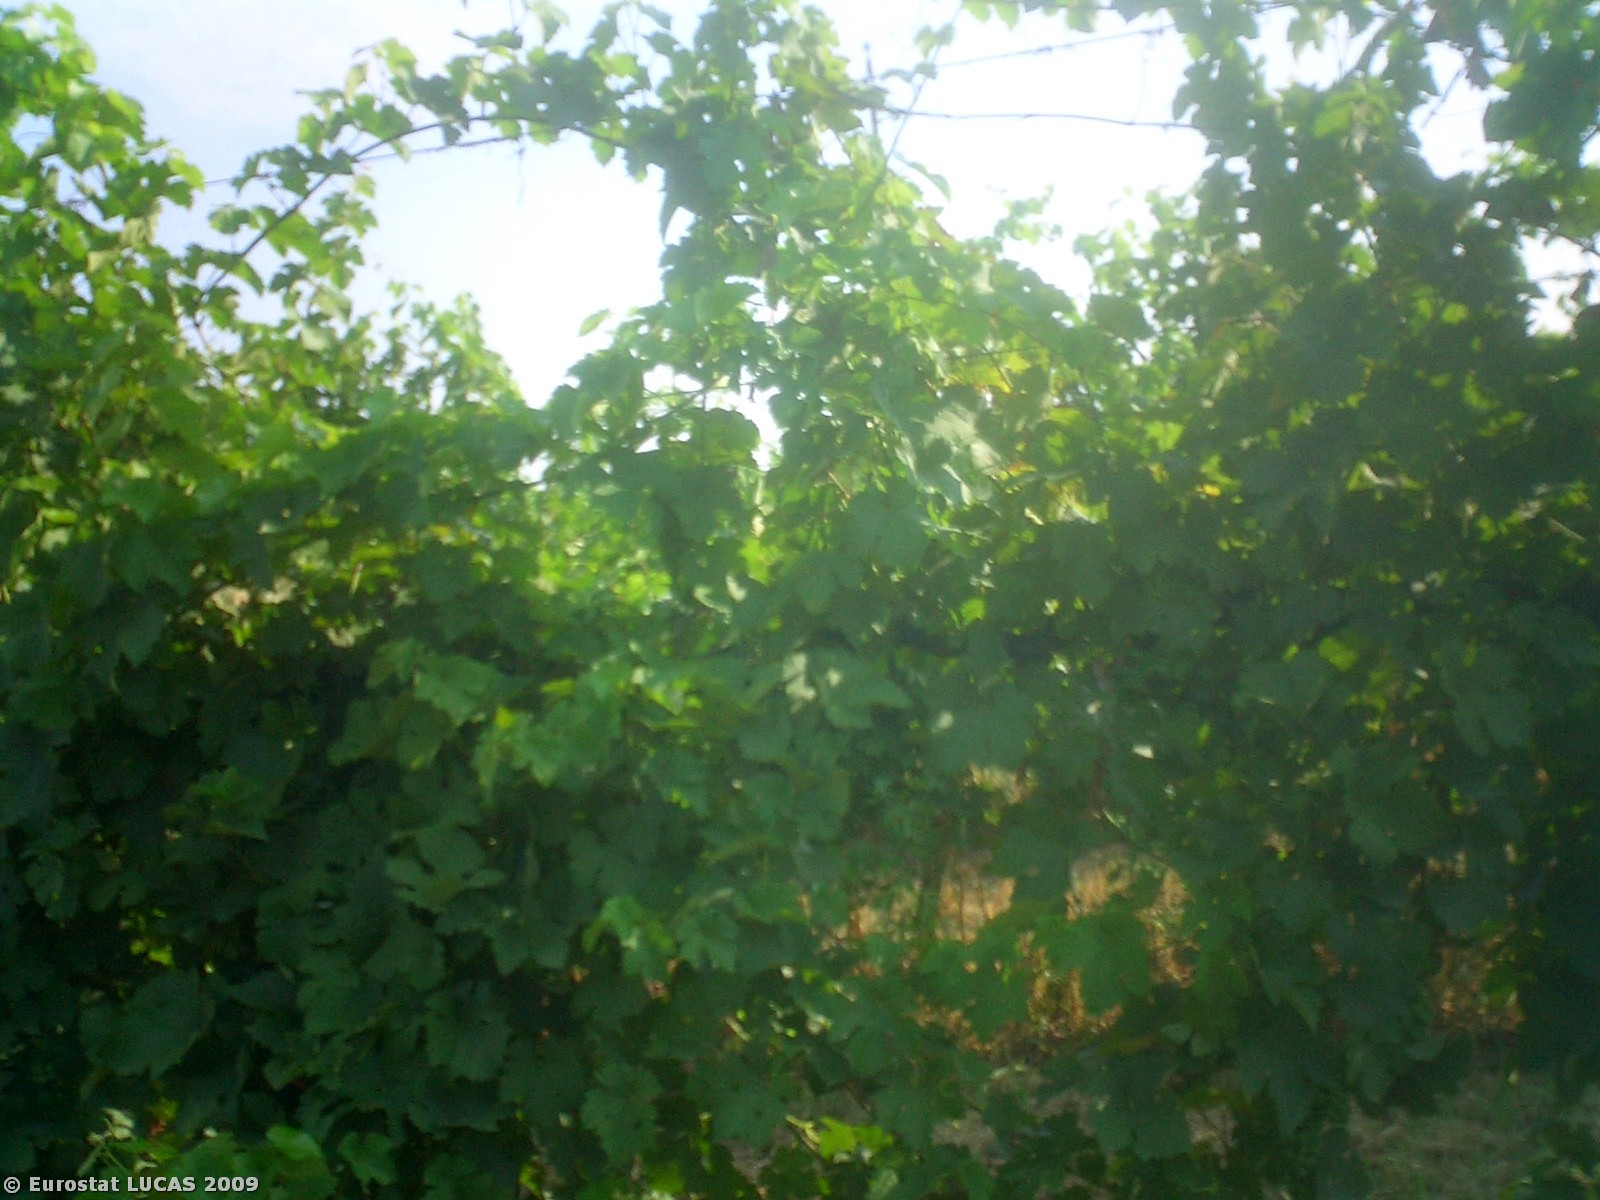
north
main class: Cropland
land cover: Vineyards
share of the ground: 50 - 75 %
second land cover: Grassland with sparse tree/shrub cover
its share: 50 - 75 %
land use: Agriculture (excluding fallow land and kitchen gardens)
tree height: < 5 m
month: July
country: IT
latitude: 44.4942
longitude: 11.9702
